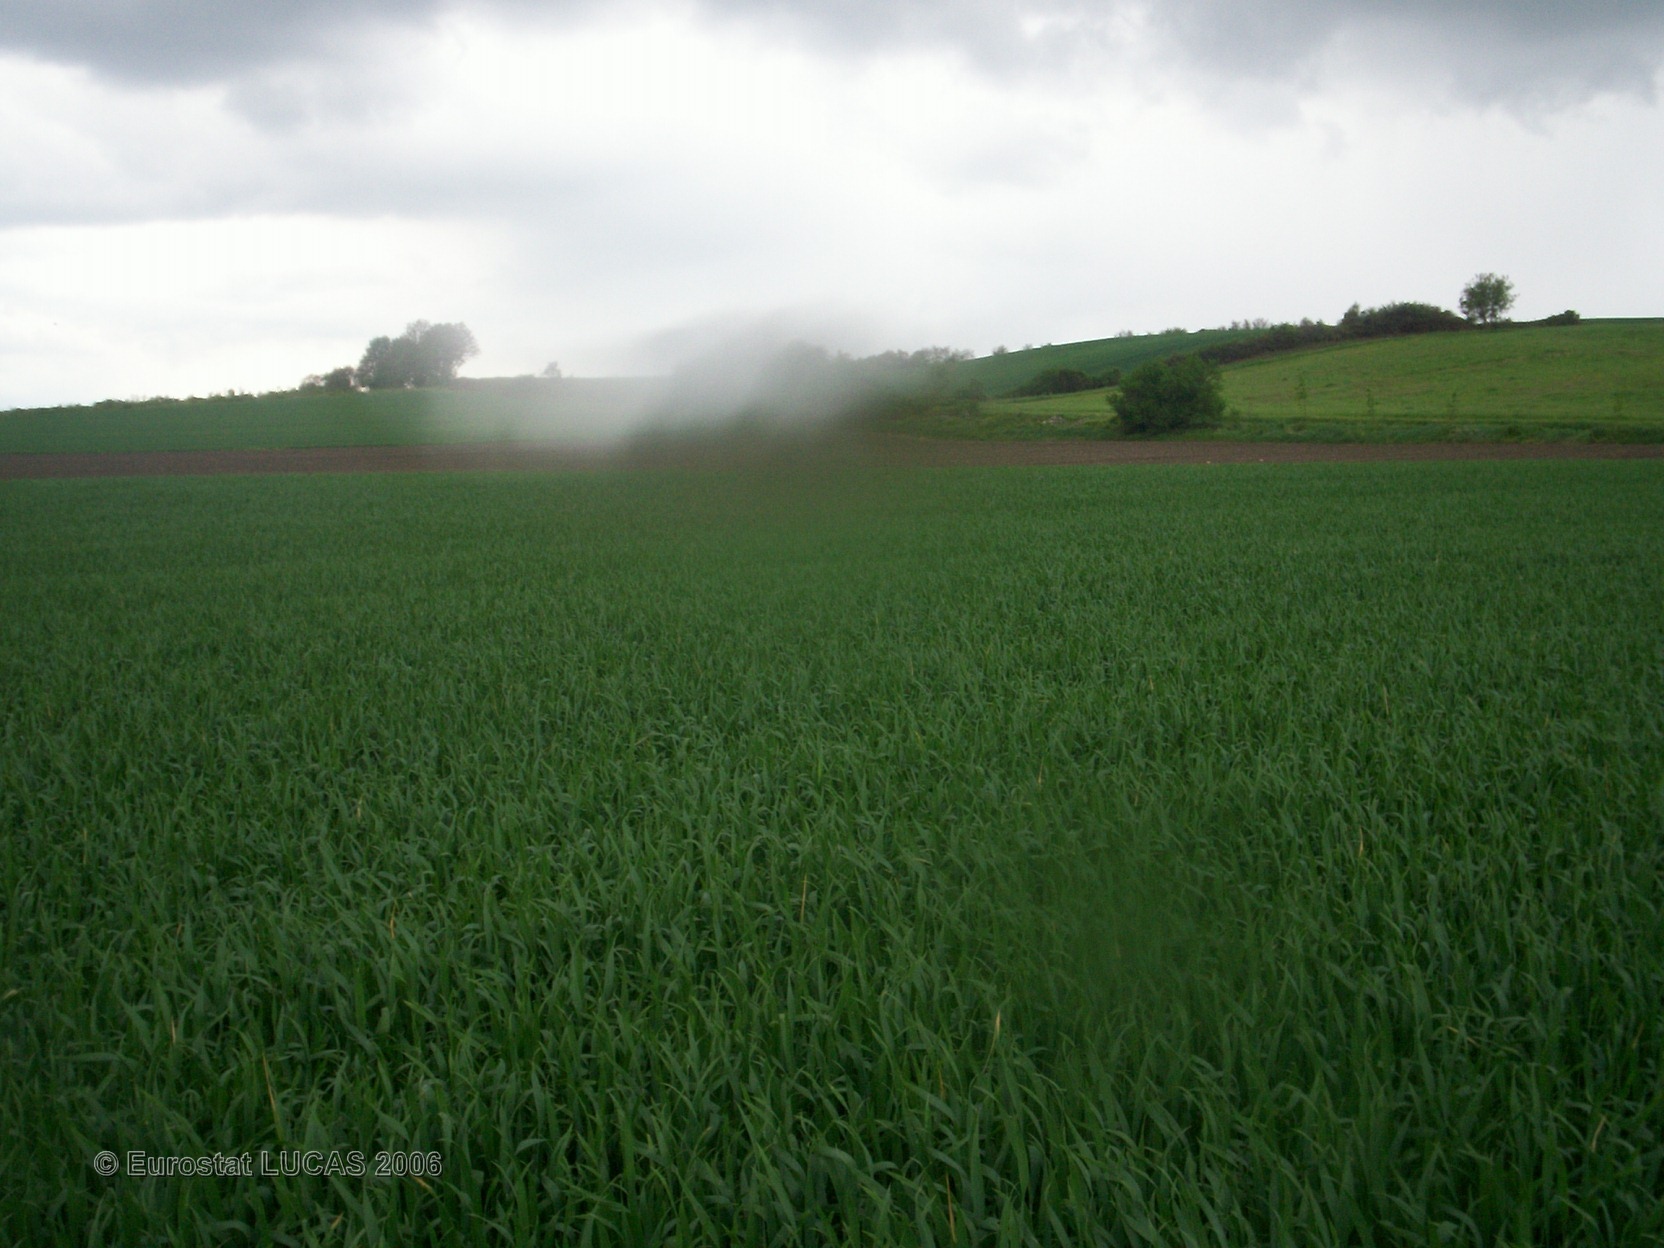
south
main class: Cropland
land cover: Common wheat
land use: Agriculture (excluding fallow land and kitchen gardens)
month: May
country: FR
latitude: 45.6425
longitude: 3.1362
